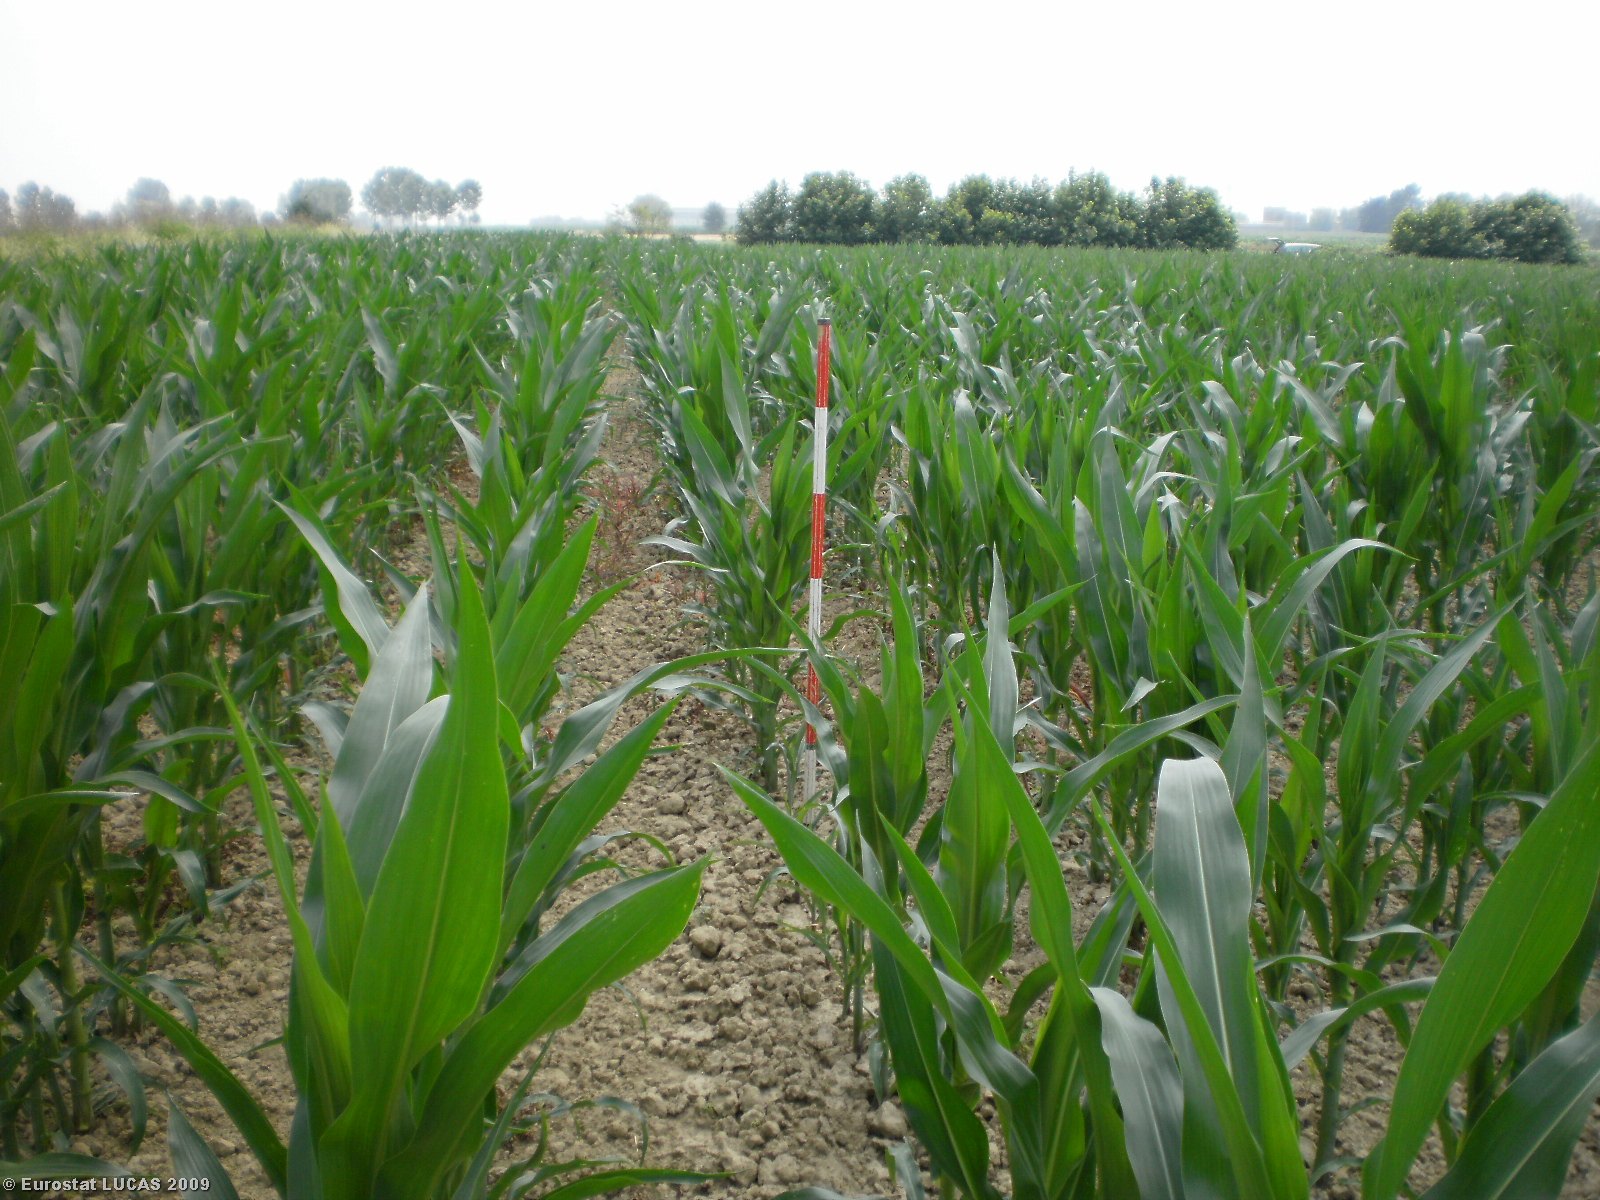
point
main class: Cropland
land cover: Maize
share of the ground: > 75 %
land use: Agriculture (excluding fallow land and kitchen gardens)
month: June
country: IT
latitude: 45.1075
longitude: 10.2664
